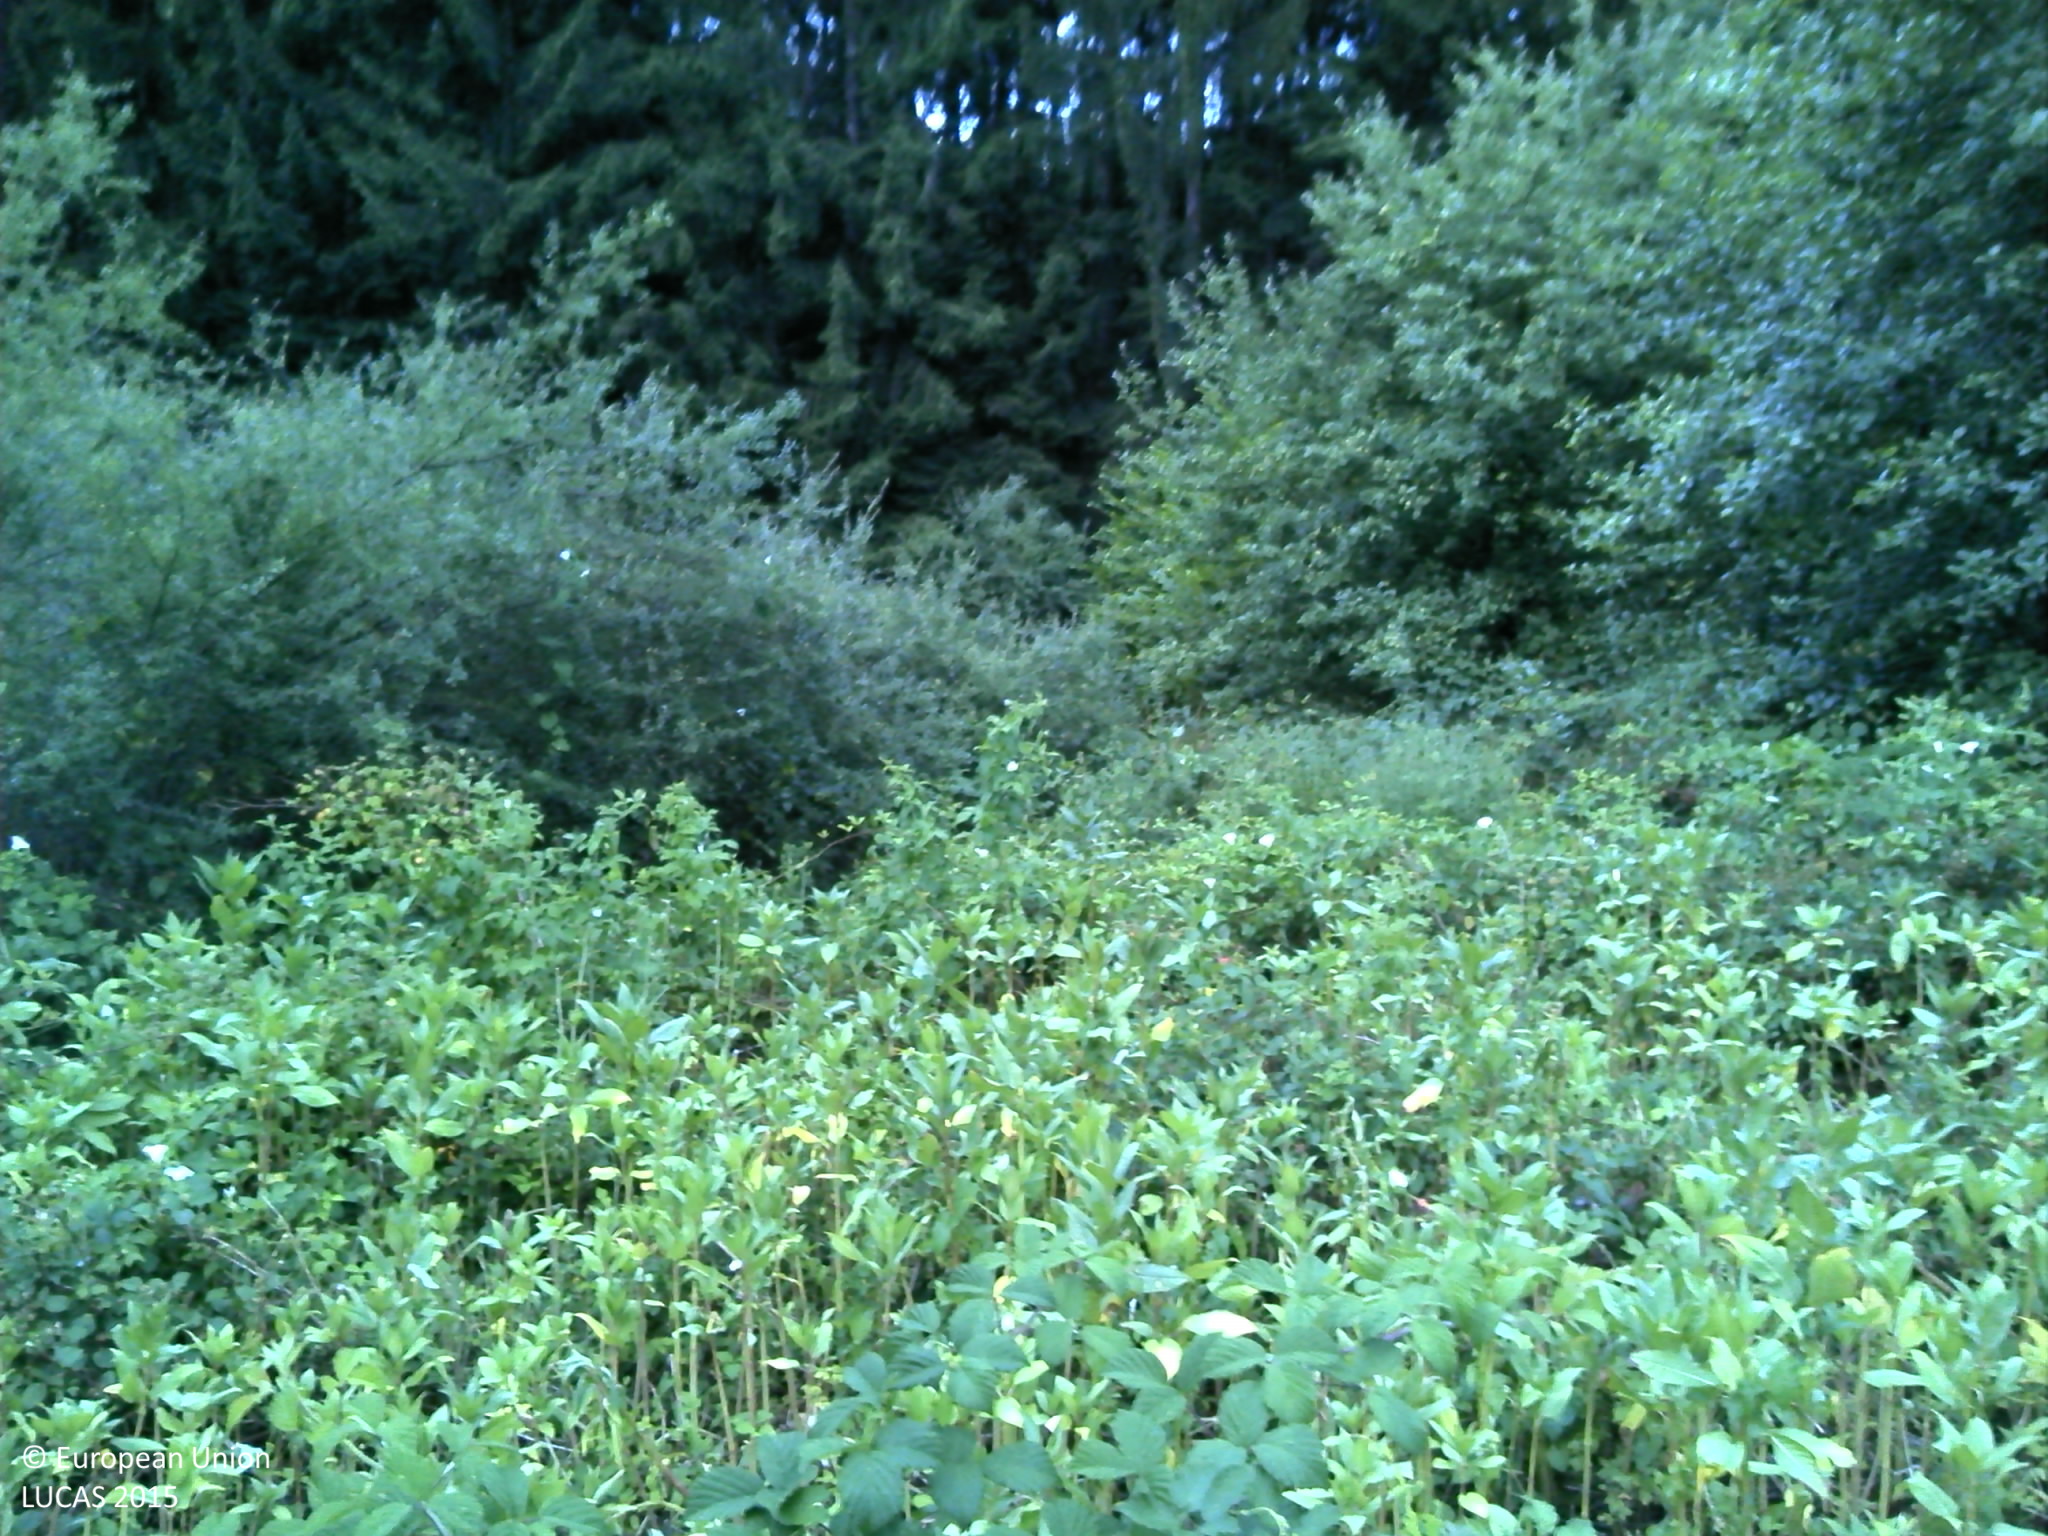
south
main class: Shrubland
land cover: Shrubland with sparse tree cover
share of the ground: > 75 %
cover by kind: shrubs 95 %, broadleaved forest trees 5 %
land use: Semi-natural and natural areas not in use
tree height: < 5 m
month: July
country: FR
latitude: 48.0520
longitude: 6.2577
